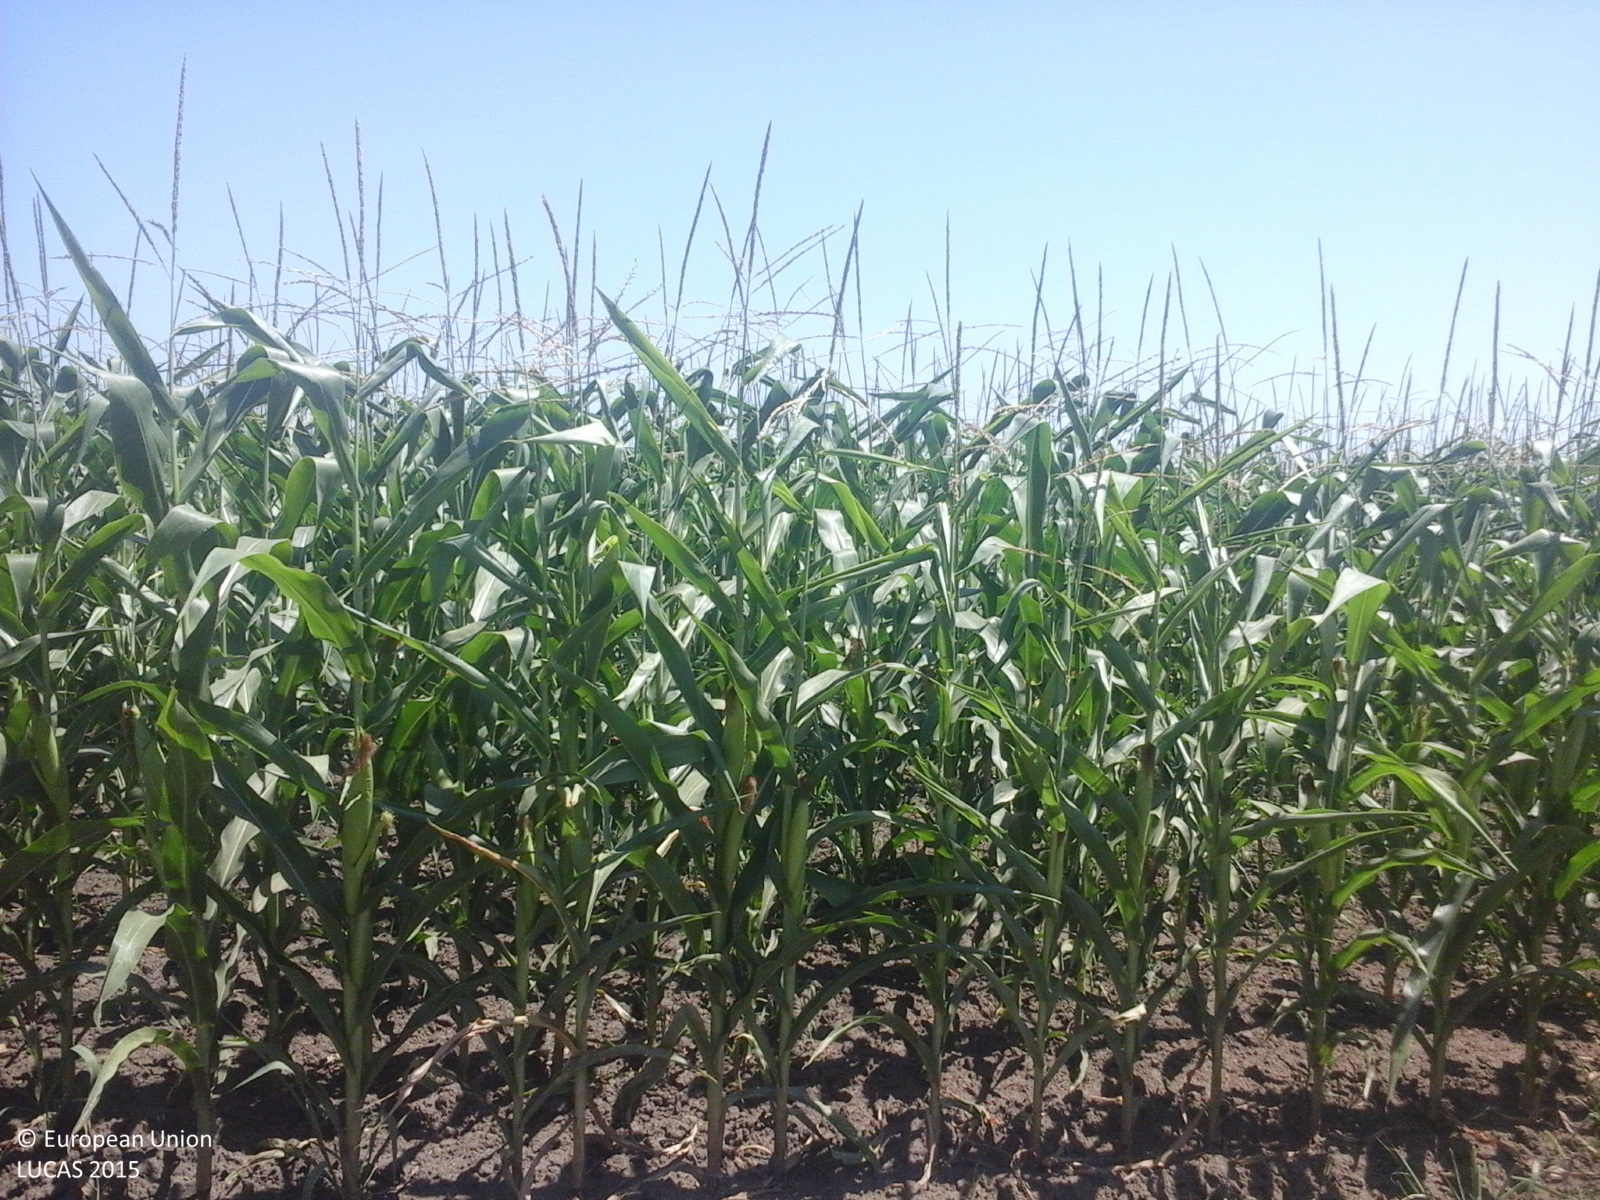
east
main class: Cropland
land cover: Maize
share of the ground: > 75 %
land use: Agriculture (excluding fallow land and kitchen gardens)
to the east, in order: Maize; Grass margins; Tracks; Grass margins; Maize
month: July
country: RO
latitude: 44.1646
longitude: 26.6867
